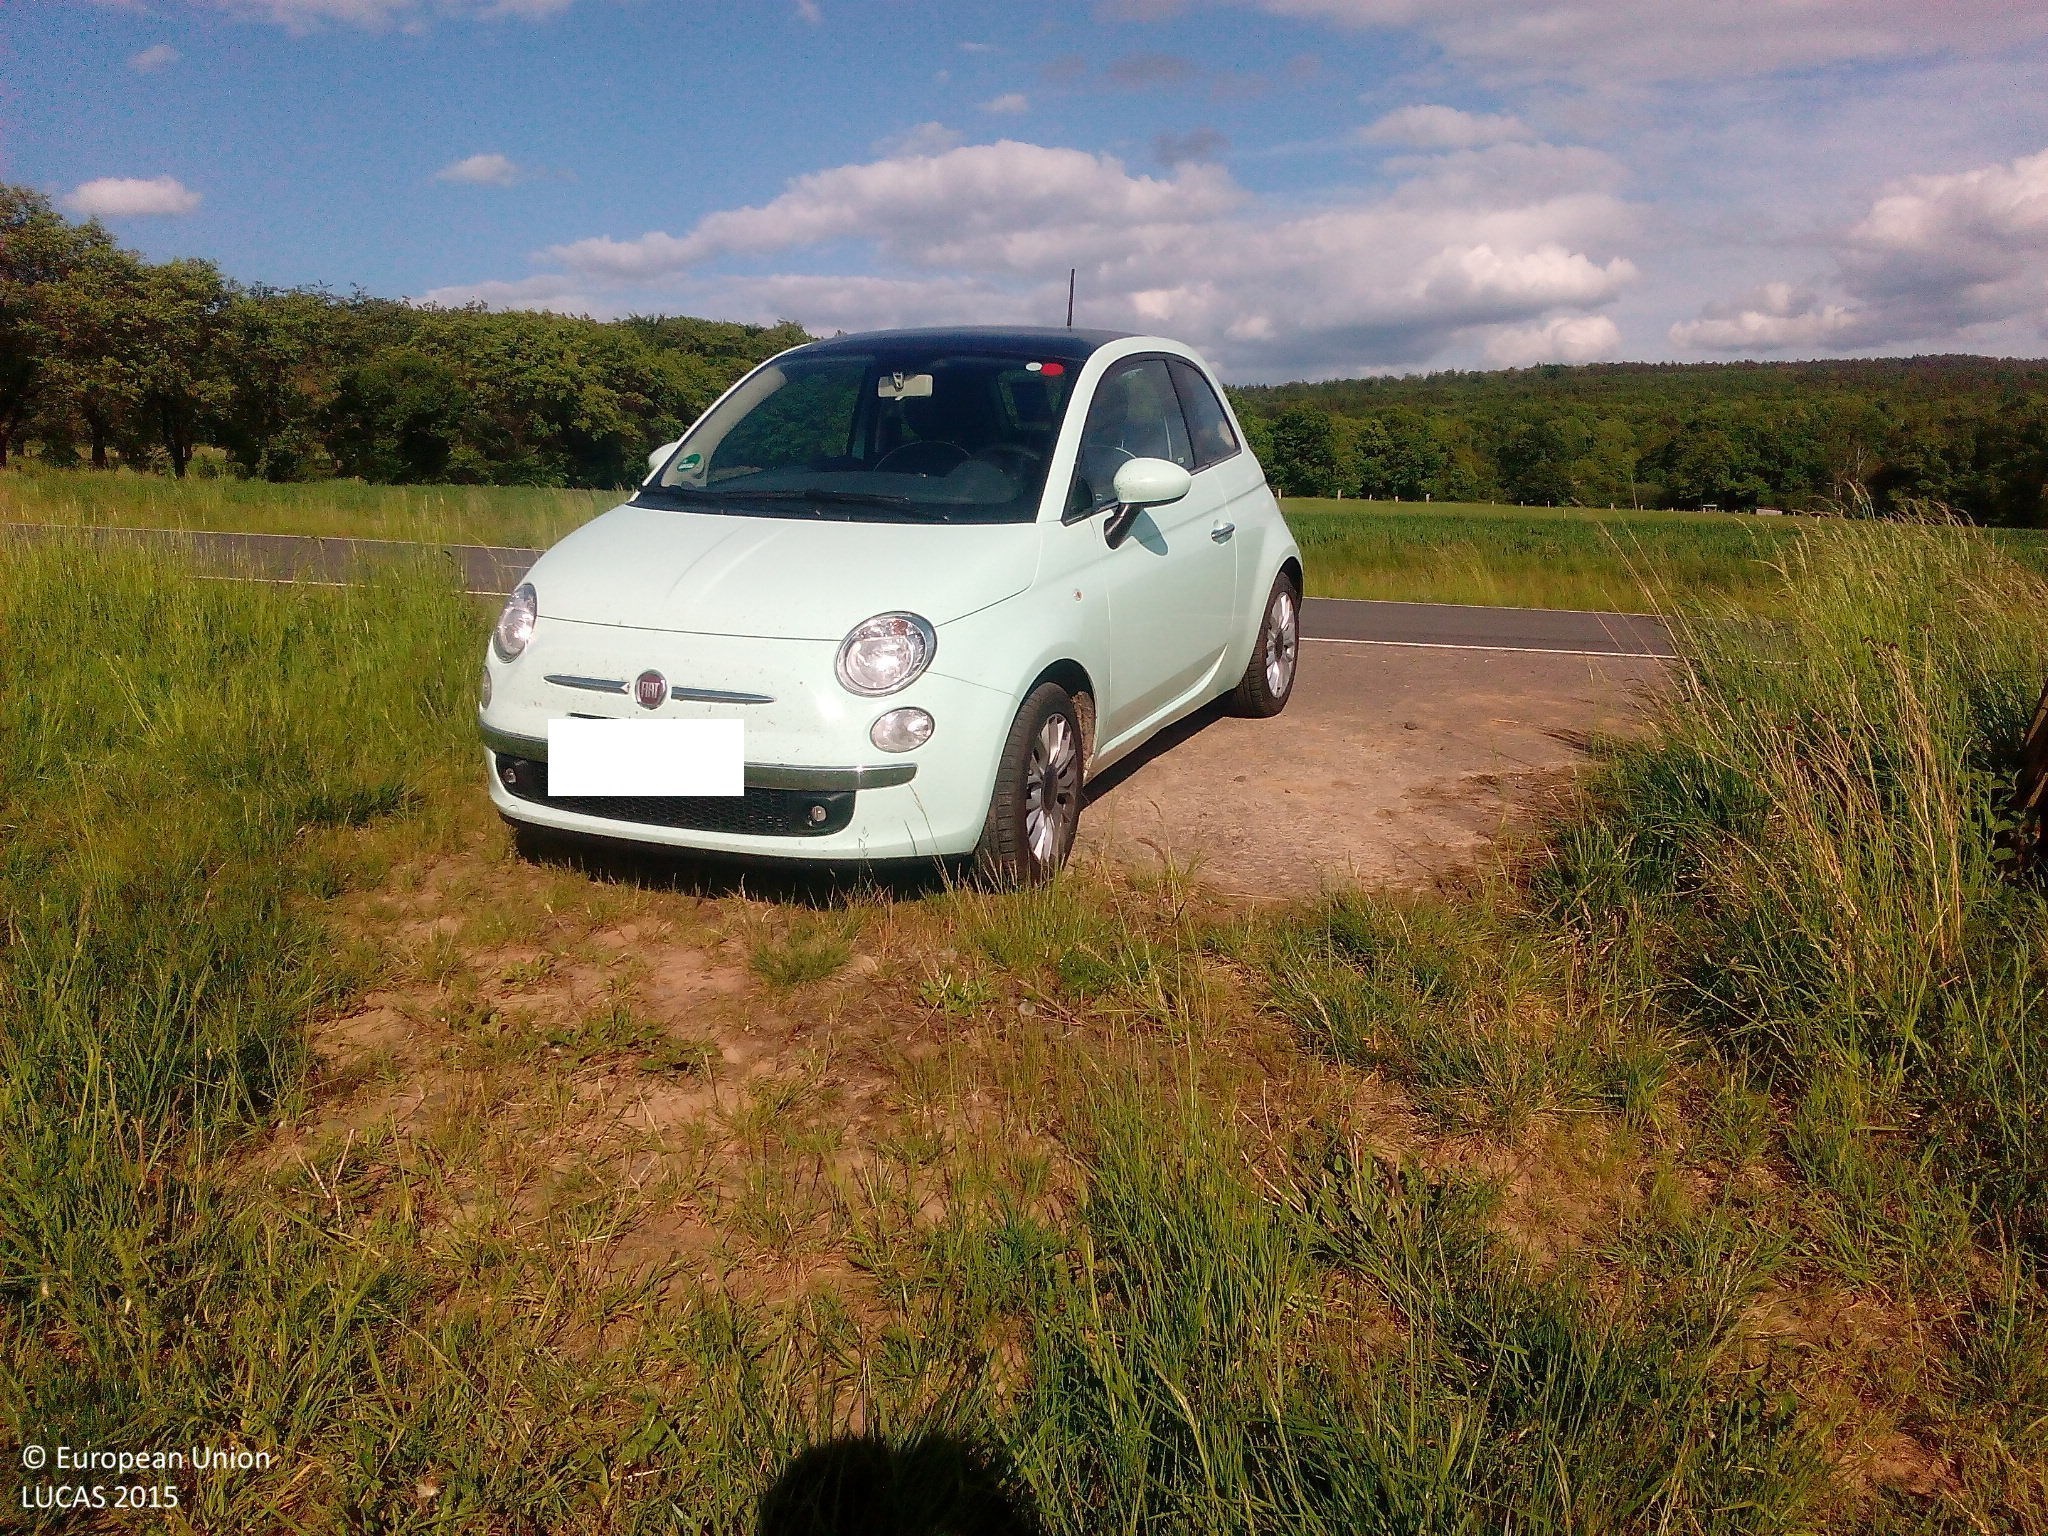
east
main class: Grassland
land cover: Grassland without tree/shrub cover
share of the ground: > 75 %
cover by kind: herbaceous plants 100 %
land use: Agriculture (excluding fallow land and kitchen gardens)
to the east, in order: Grassland without tree/shrub cover; Fences; Grass margins; Ditches and canals; Grass margins; Paved roads, cycling and walking lanes; Grass margins; Ditches and canals; Grass margins; Triticale; Fences; Grassland without tree/shrub cover
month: May
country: DE
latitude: 51.2984
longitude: 9.6416
